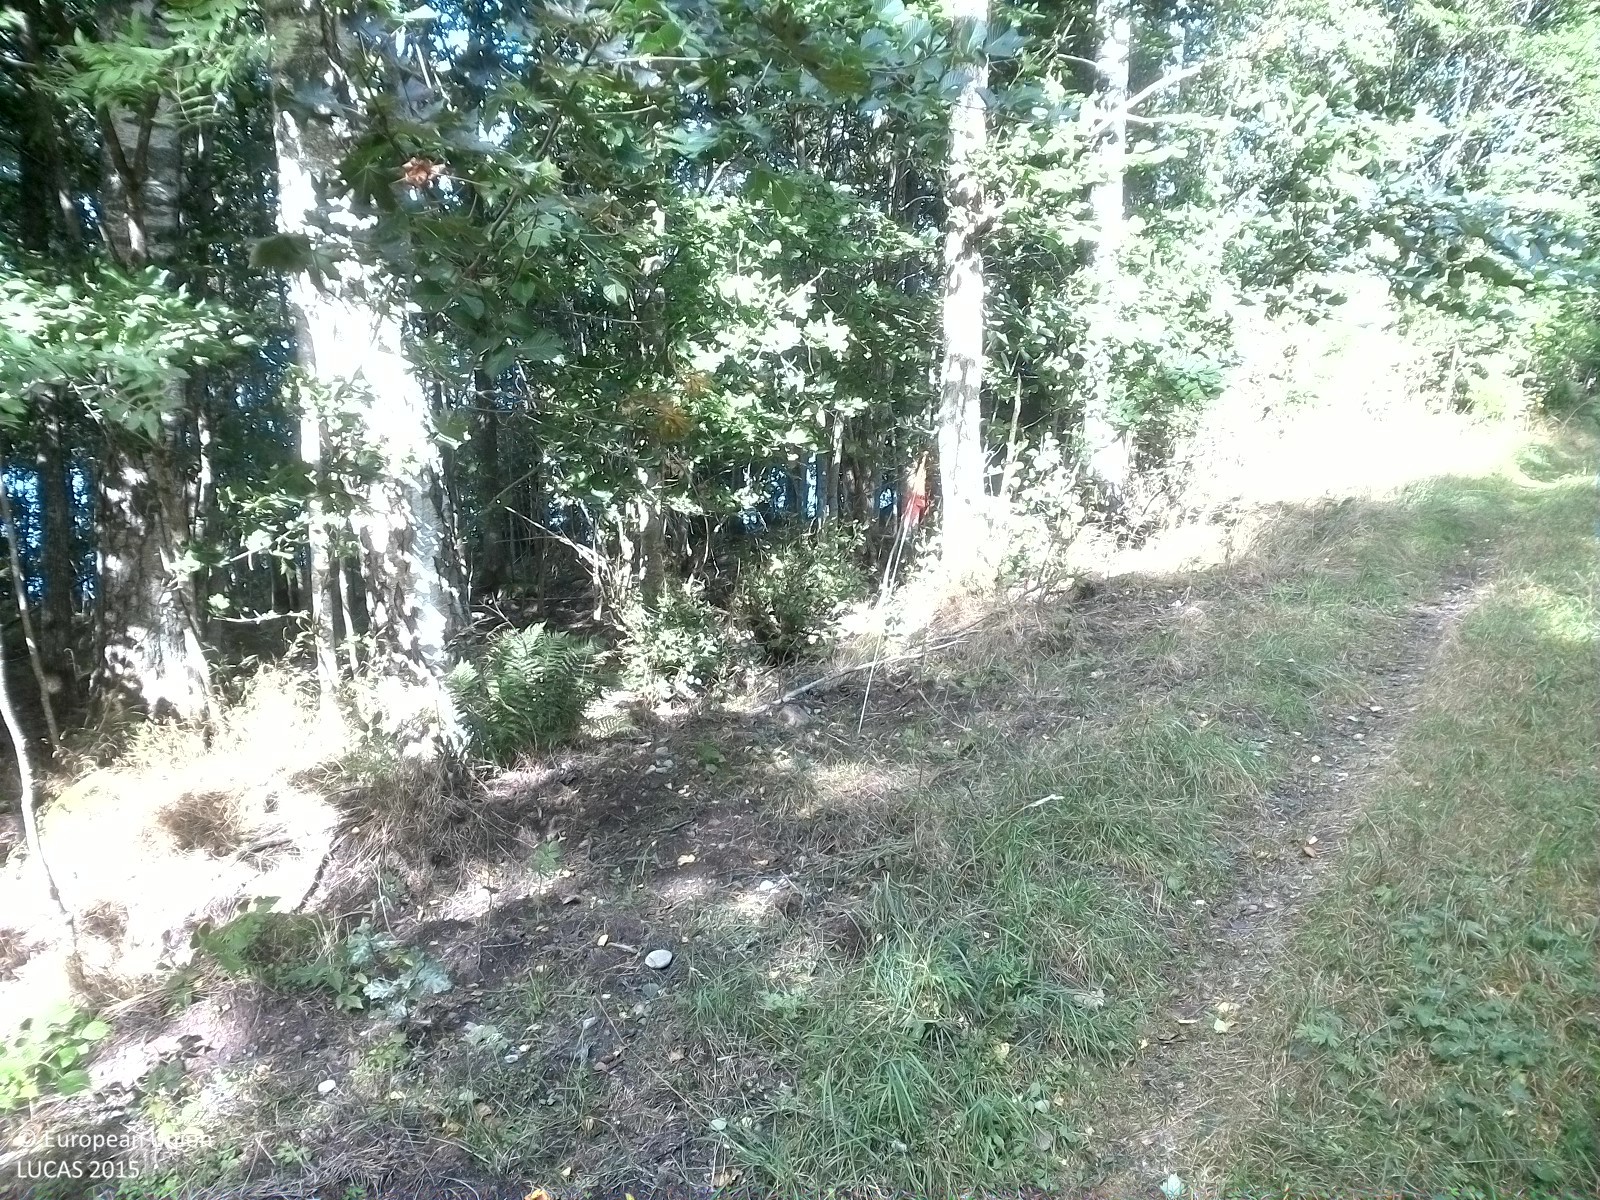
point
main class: Woodland
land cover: Broadleaved woodland
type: hemiboreal forest and nemoral coniferous forest and mixed broadleaved-coniferous forest
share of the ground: 50 - 75 %
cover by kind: broadleaved forest trees 60 %, unconsolidated bare surface 20 %, herbaceous plants 10 %, shrubs 5 %, lichens and mosses 5 %
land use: Forestry
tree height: > 5 m
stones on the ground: 10 - 25 %
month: September
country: SE
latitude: 59.1388
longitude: 15.8477
